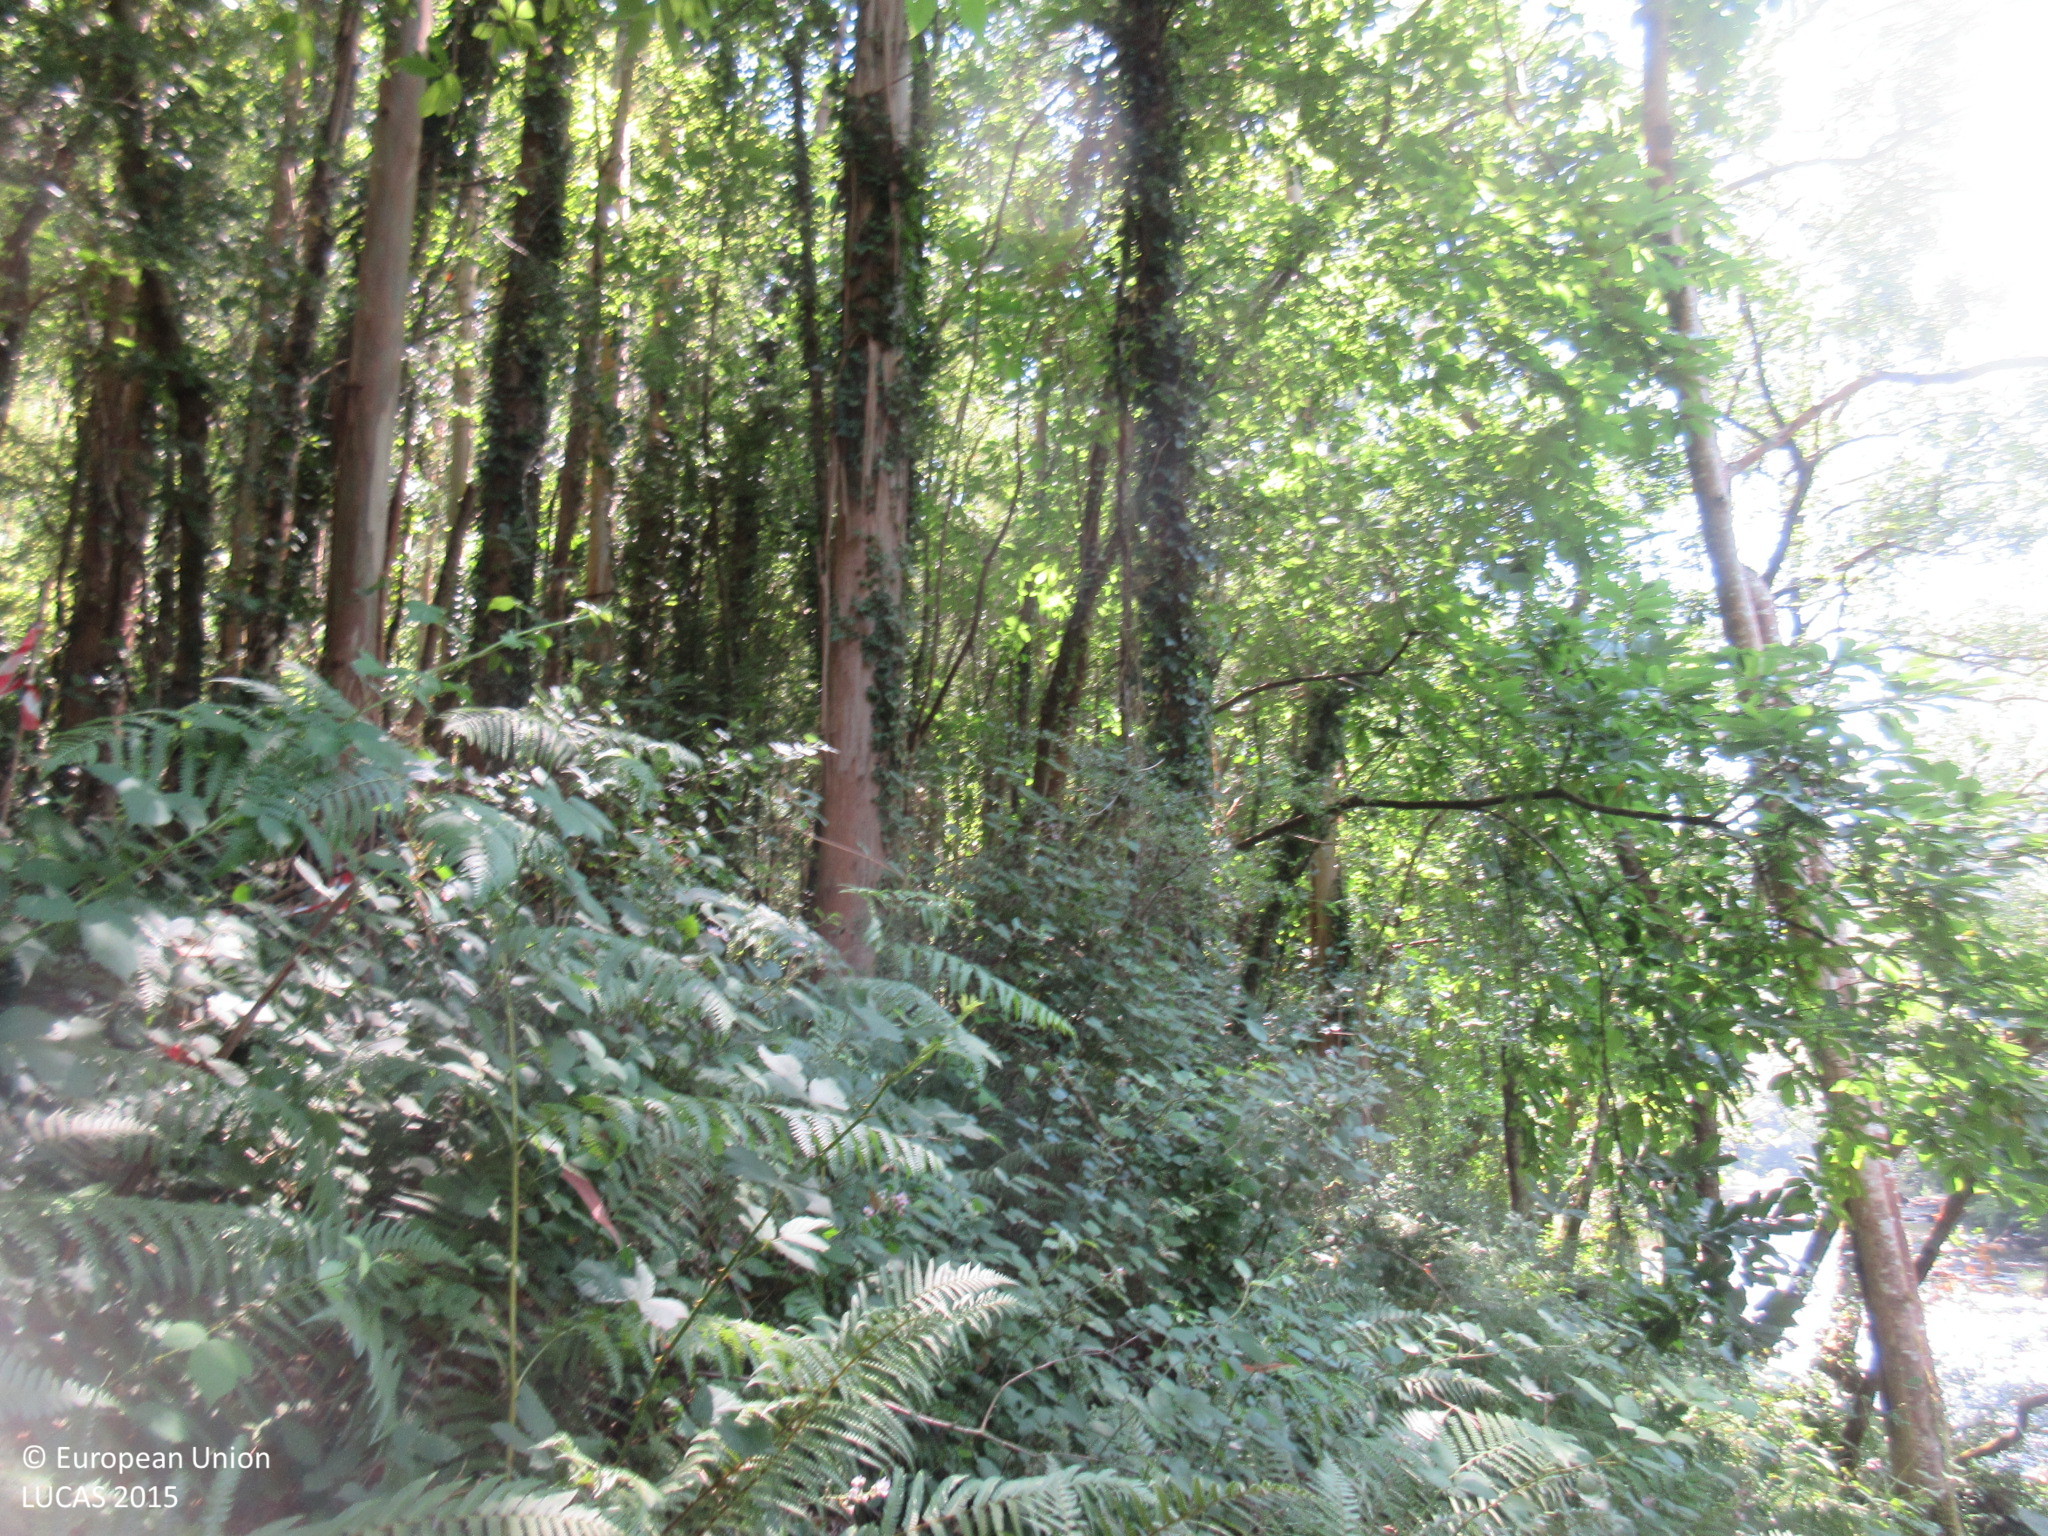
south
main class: Woodland
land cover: Broadleaved woodland
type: exotic forest
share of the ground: > 75 %
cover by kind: broadleaved forest trees 95 %, shrubs 5 %
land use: Forestry
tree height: > 5 m
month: June
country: ES
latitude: 43.4028
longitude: -7.1730
